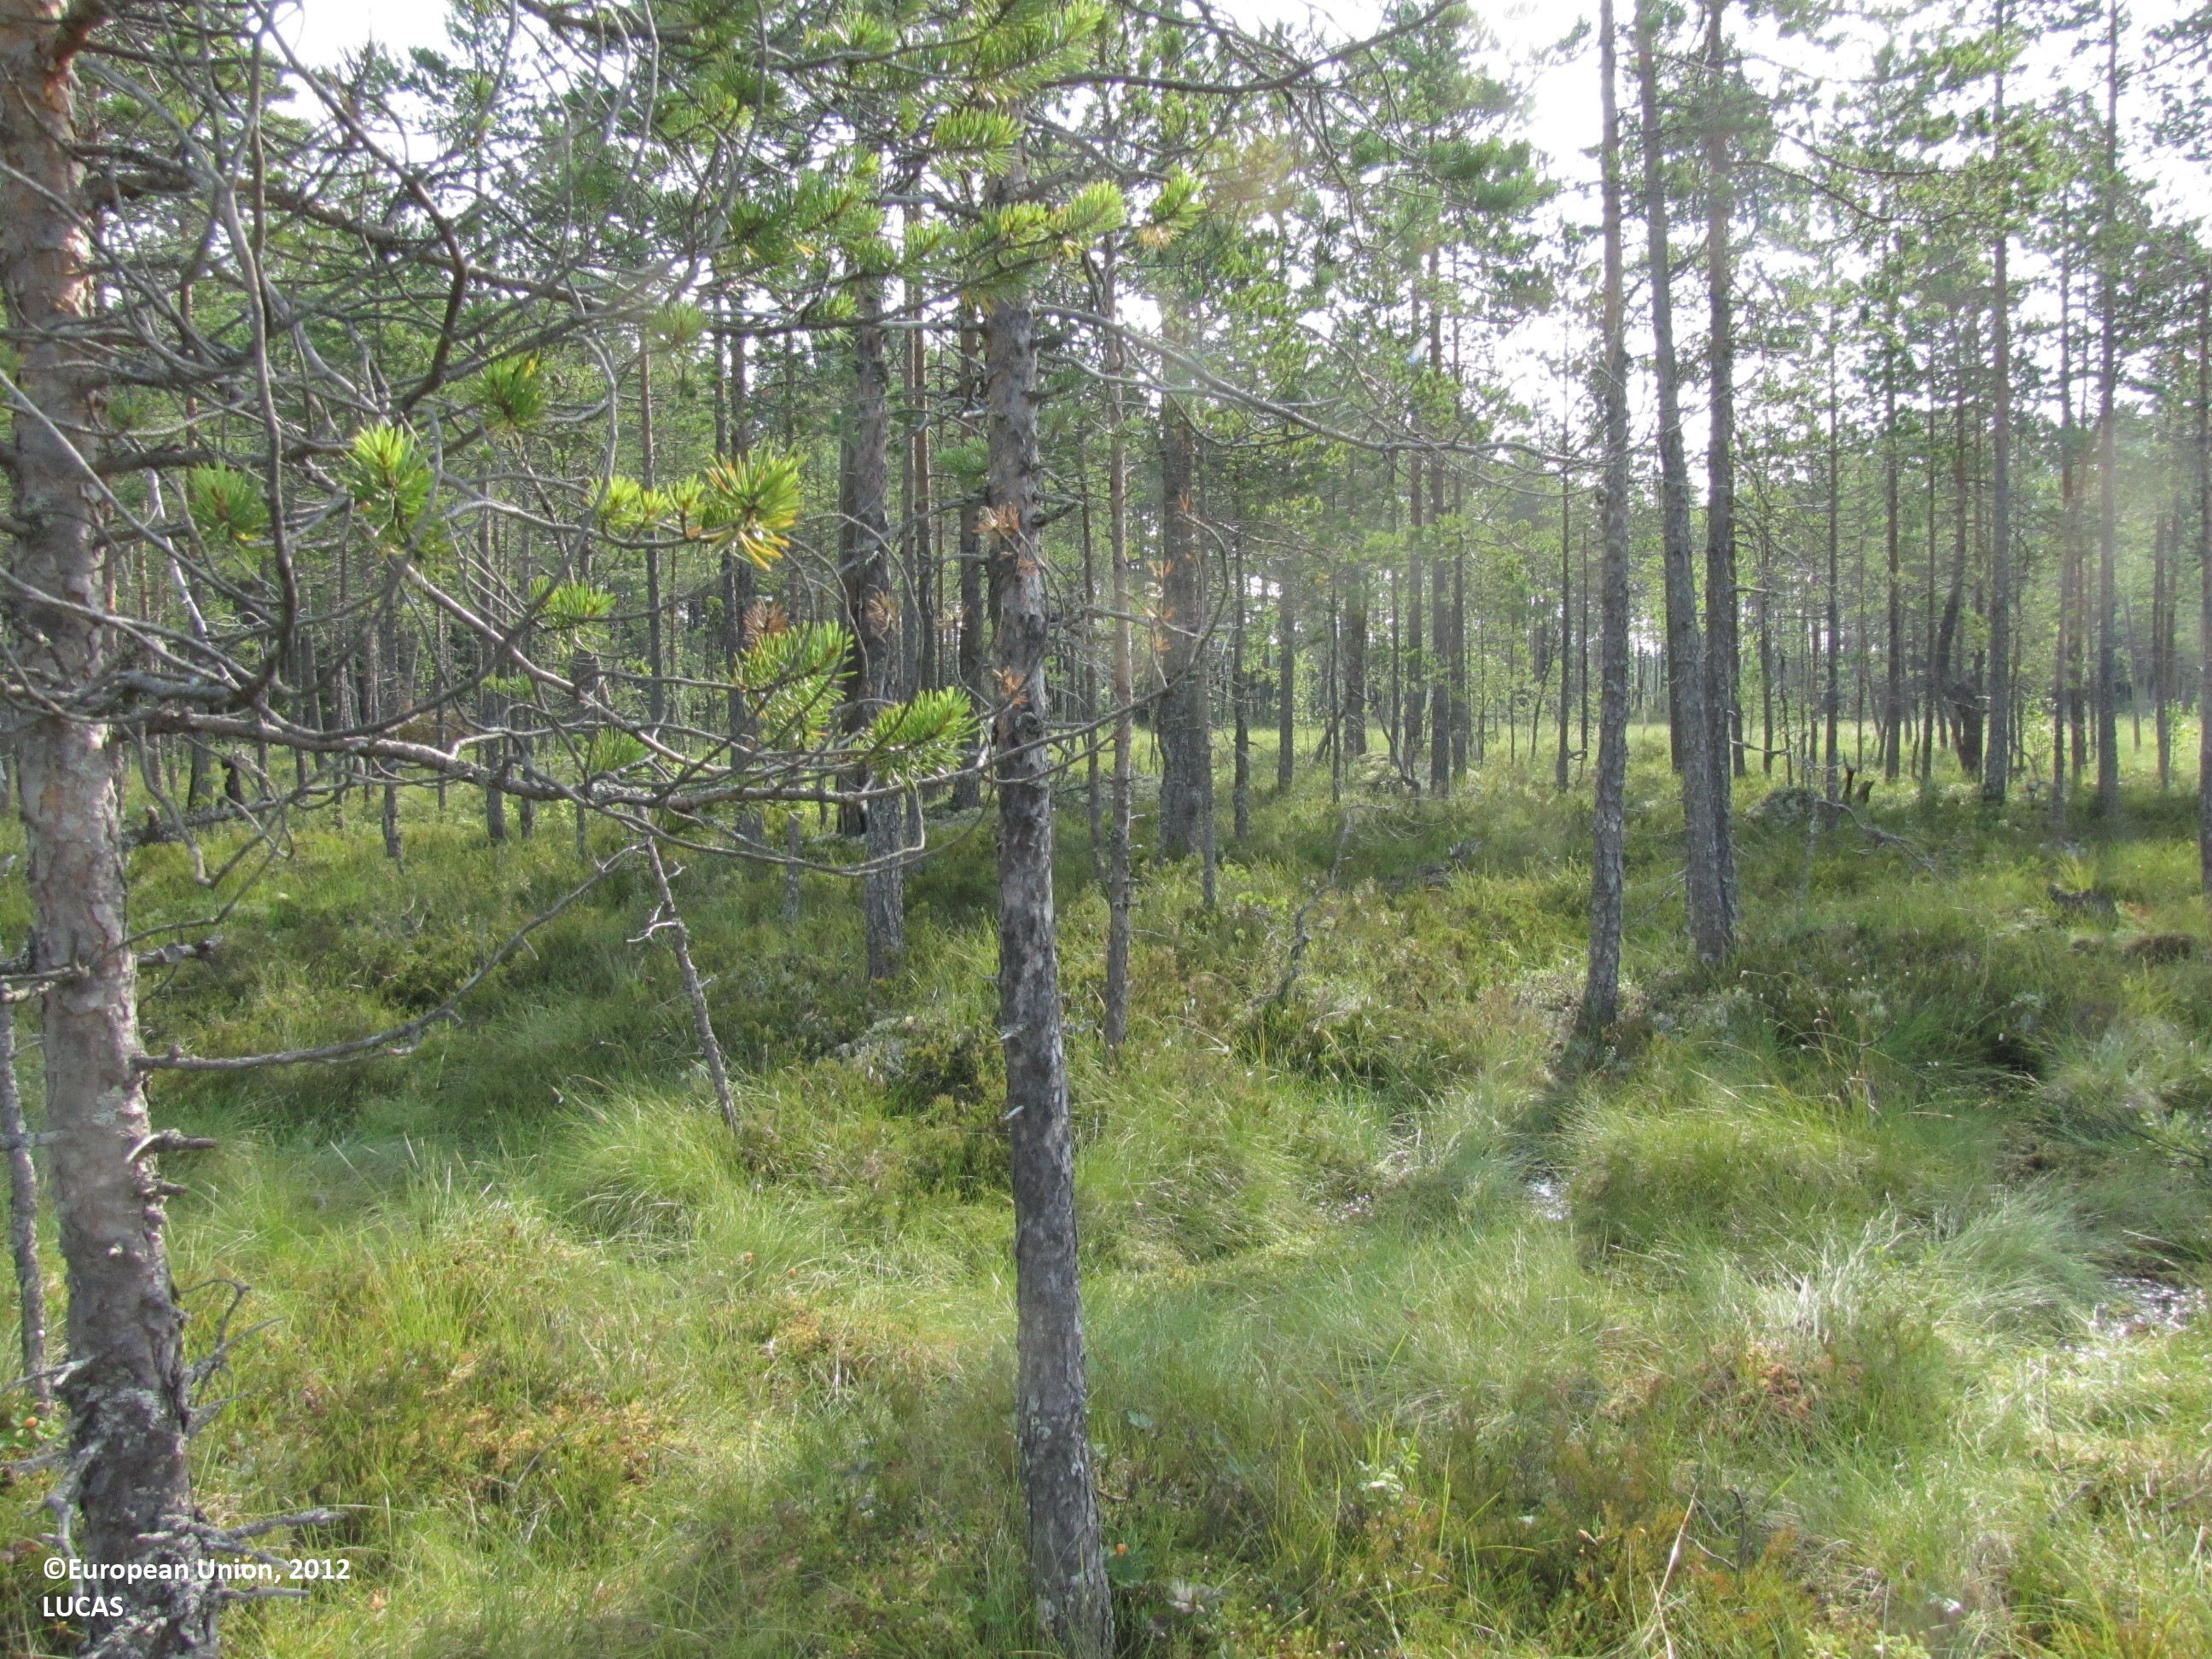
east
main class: Woodland
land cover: Pine dominated coniferous woodland
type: mire and swamp forests
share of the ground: 25 - 50 %
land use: Community services
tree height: < 5 m
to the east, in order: Pine dominated coniferous woodland
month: July
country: FI
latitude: 62.0566
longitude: 23.2896
